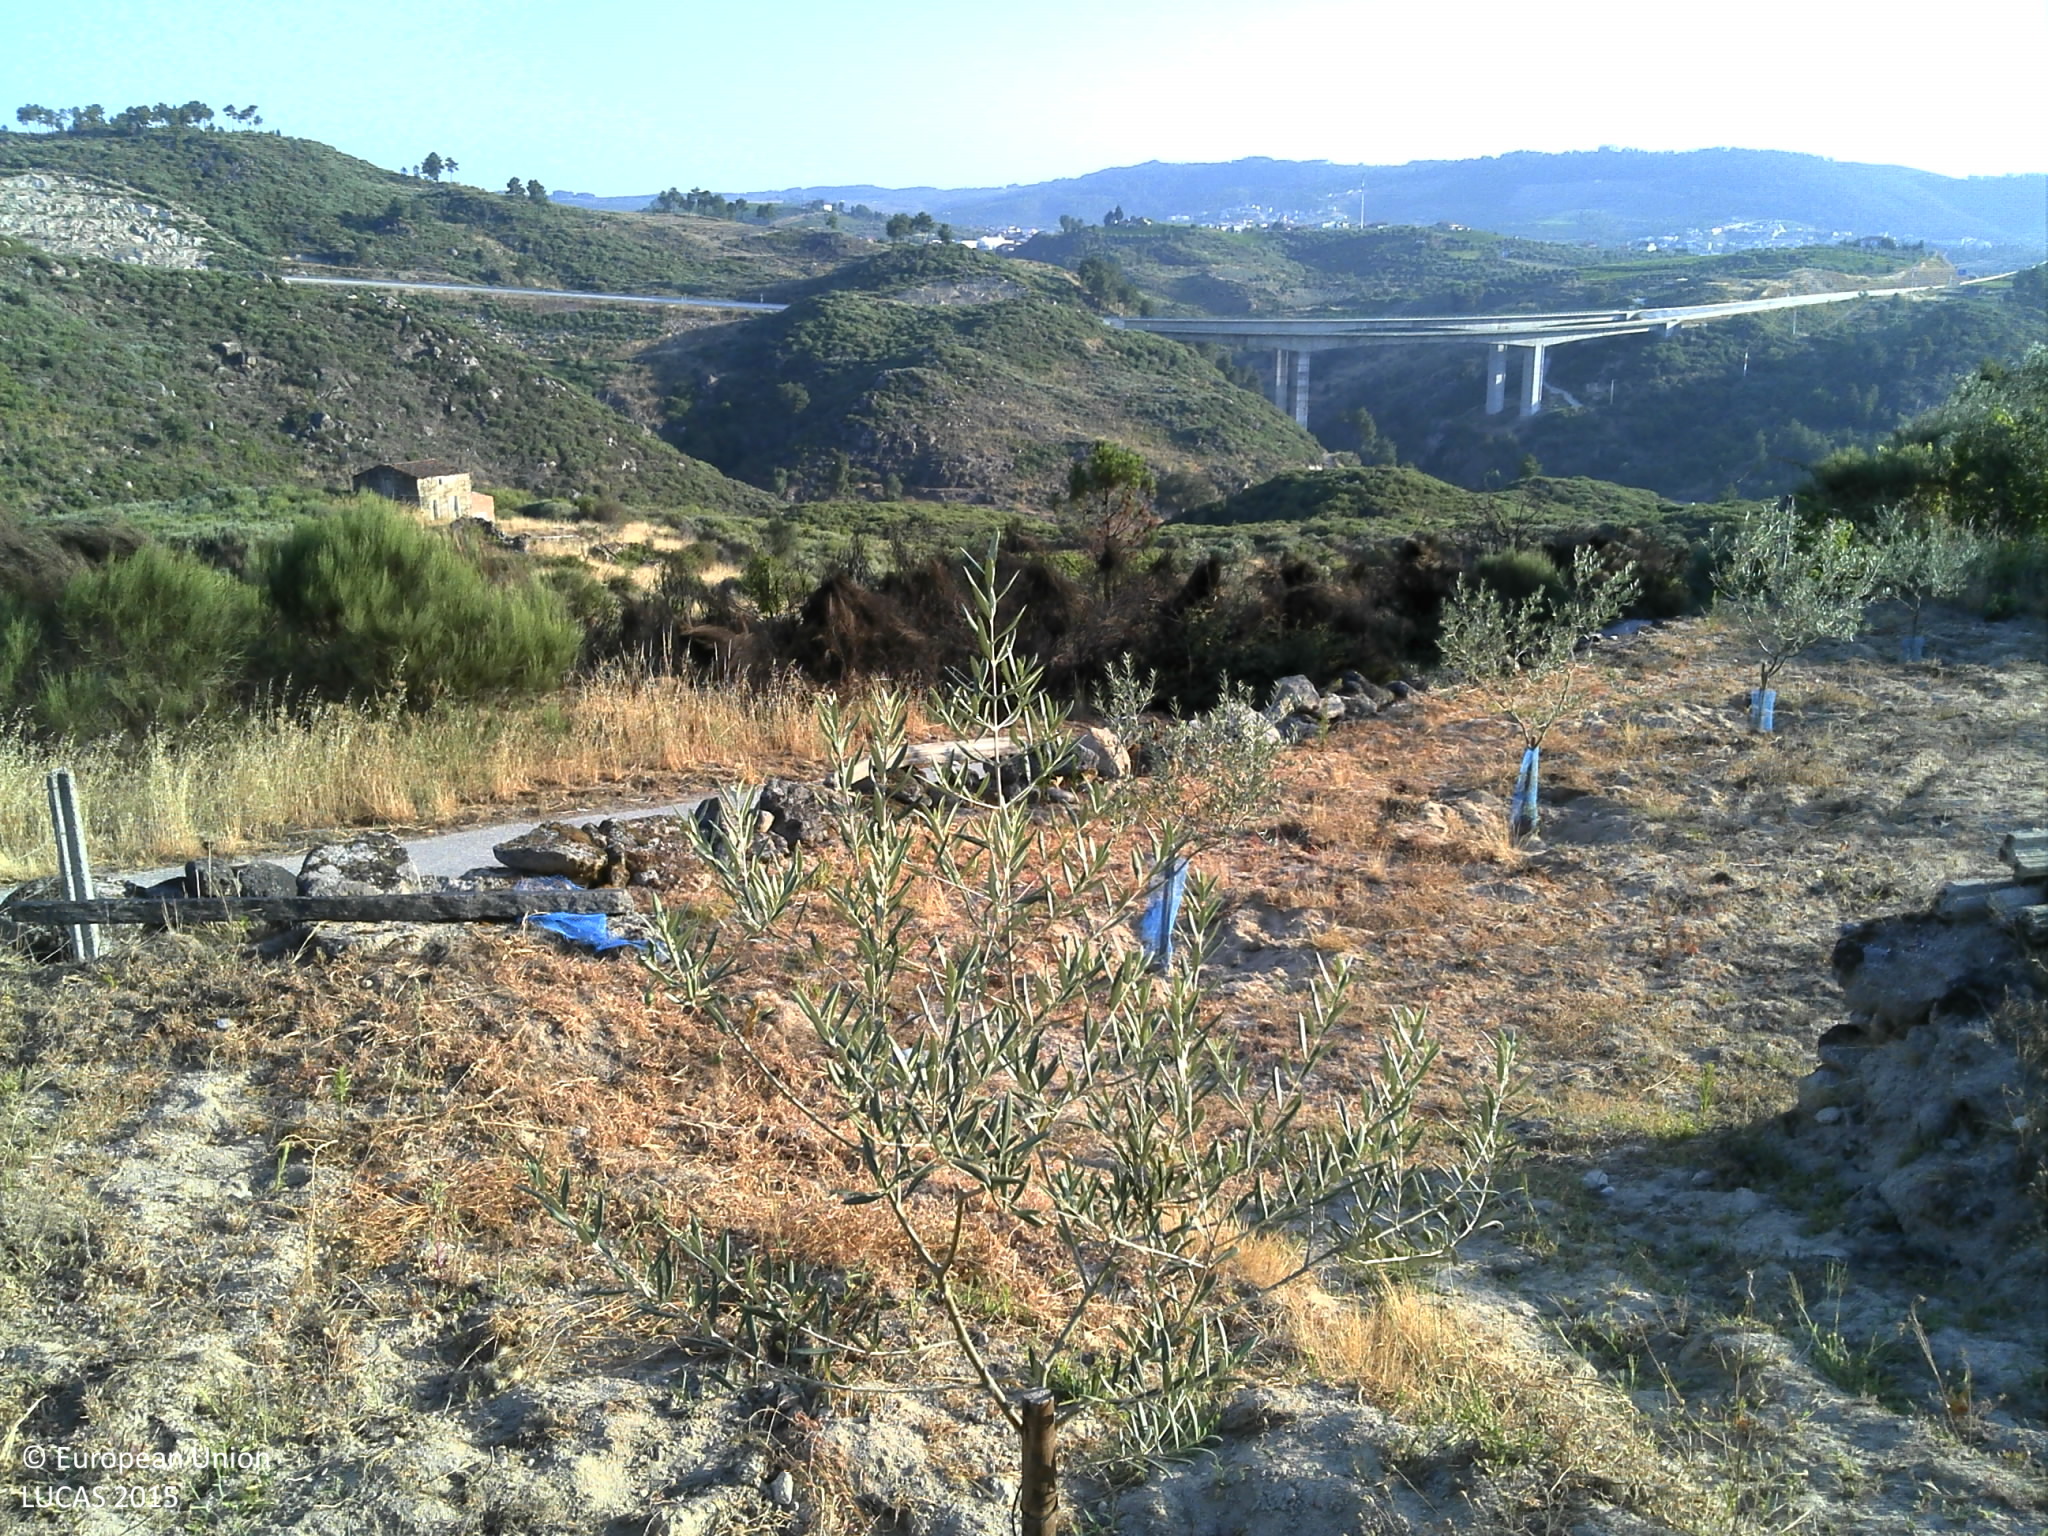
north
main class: Cropland
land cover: Olive groves
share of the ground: < 10 %
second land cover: Other bare soil
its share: > 75 %
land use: Agriculture (excluding fallow land and kitchen gardens)
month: July
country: PT
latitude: 41.3832
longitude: -7.4513
